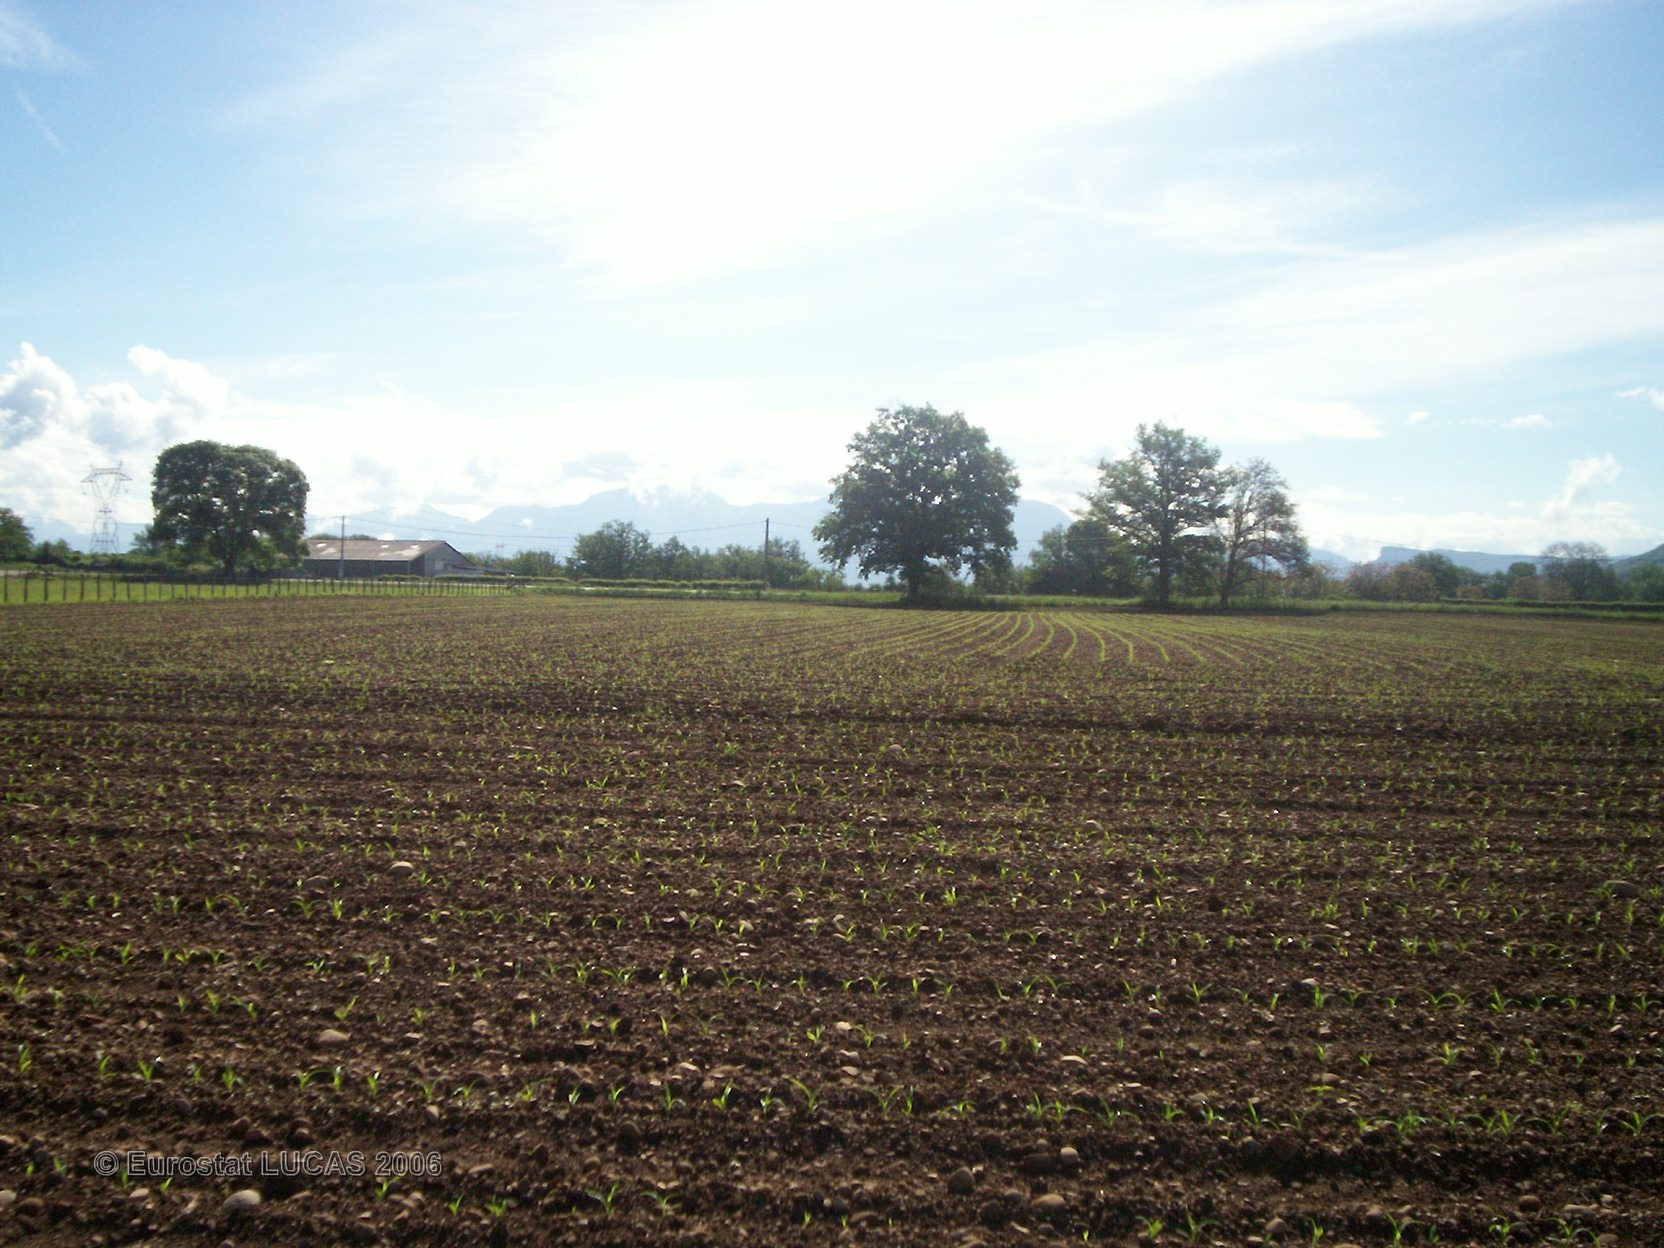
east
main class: Cropland
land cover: Maize
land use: Agriculture (excluding fallow land and kitchen gardens)
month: May
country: FR
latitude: 45.3510
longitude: 5.4227
